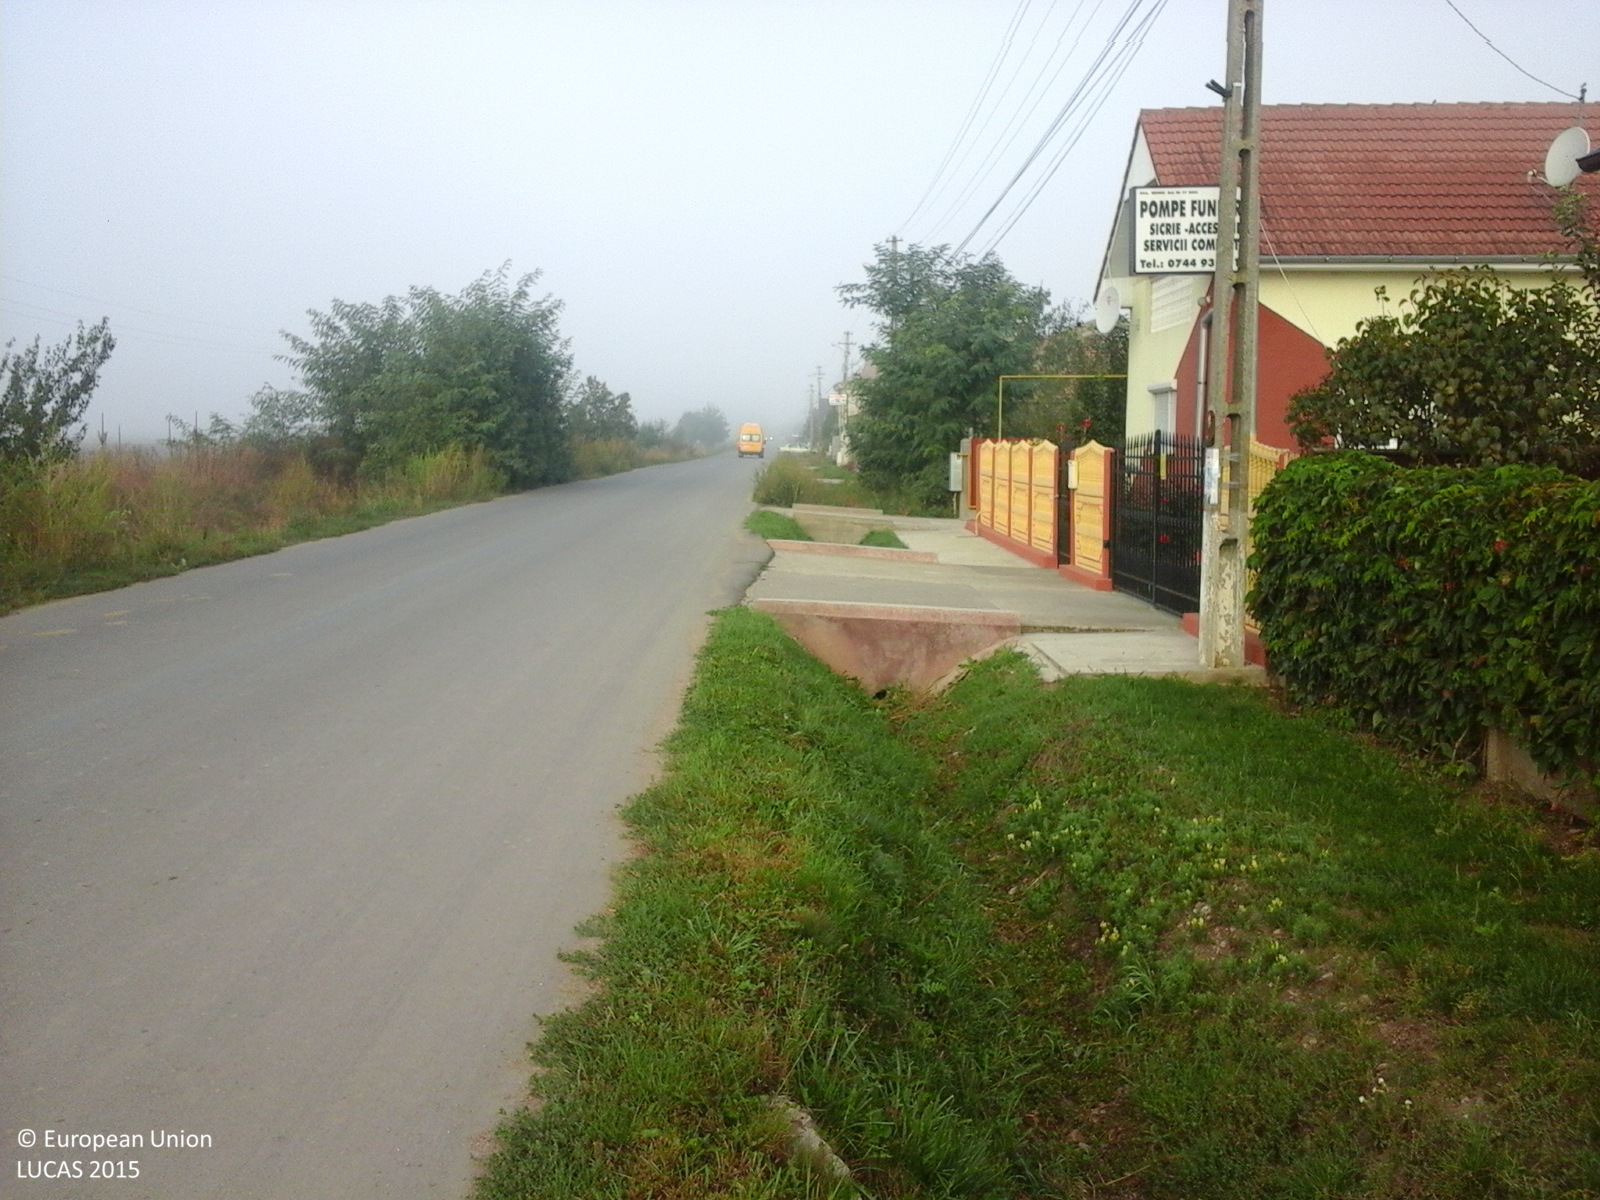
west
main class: Grassland
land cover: Grassland without tree/shrub cover
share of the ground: > 75 %
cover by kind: herbaceous plants 100 %
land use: Agriculture (excluding fallow land and kitchen gardens)
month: September
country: RO
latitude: 46.8598
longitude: 23.7823
